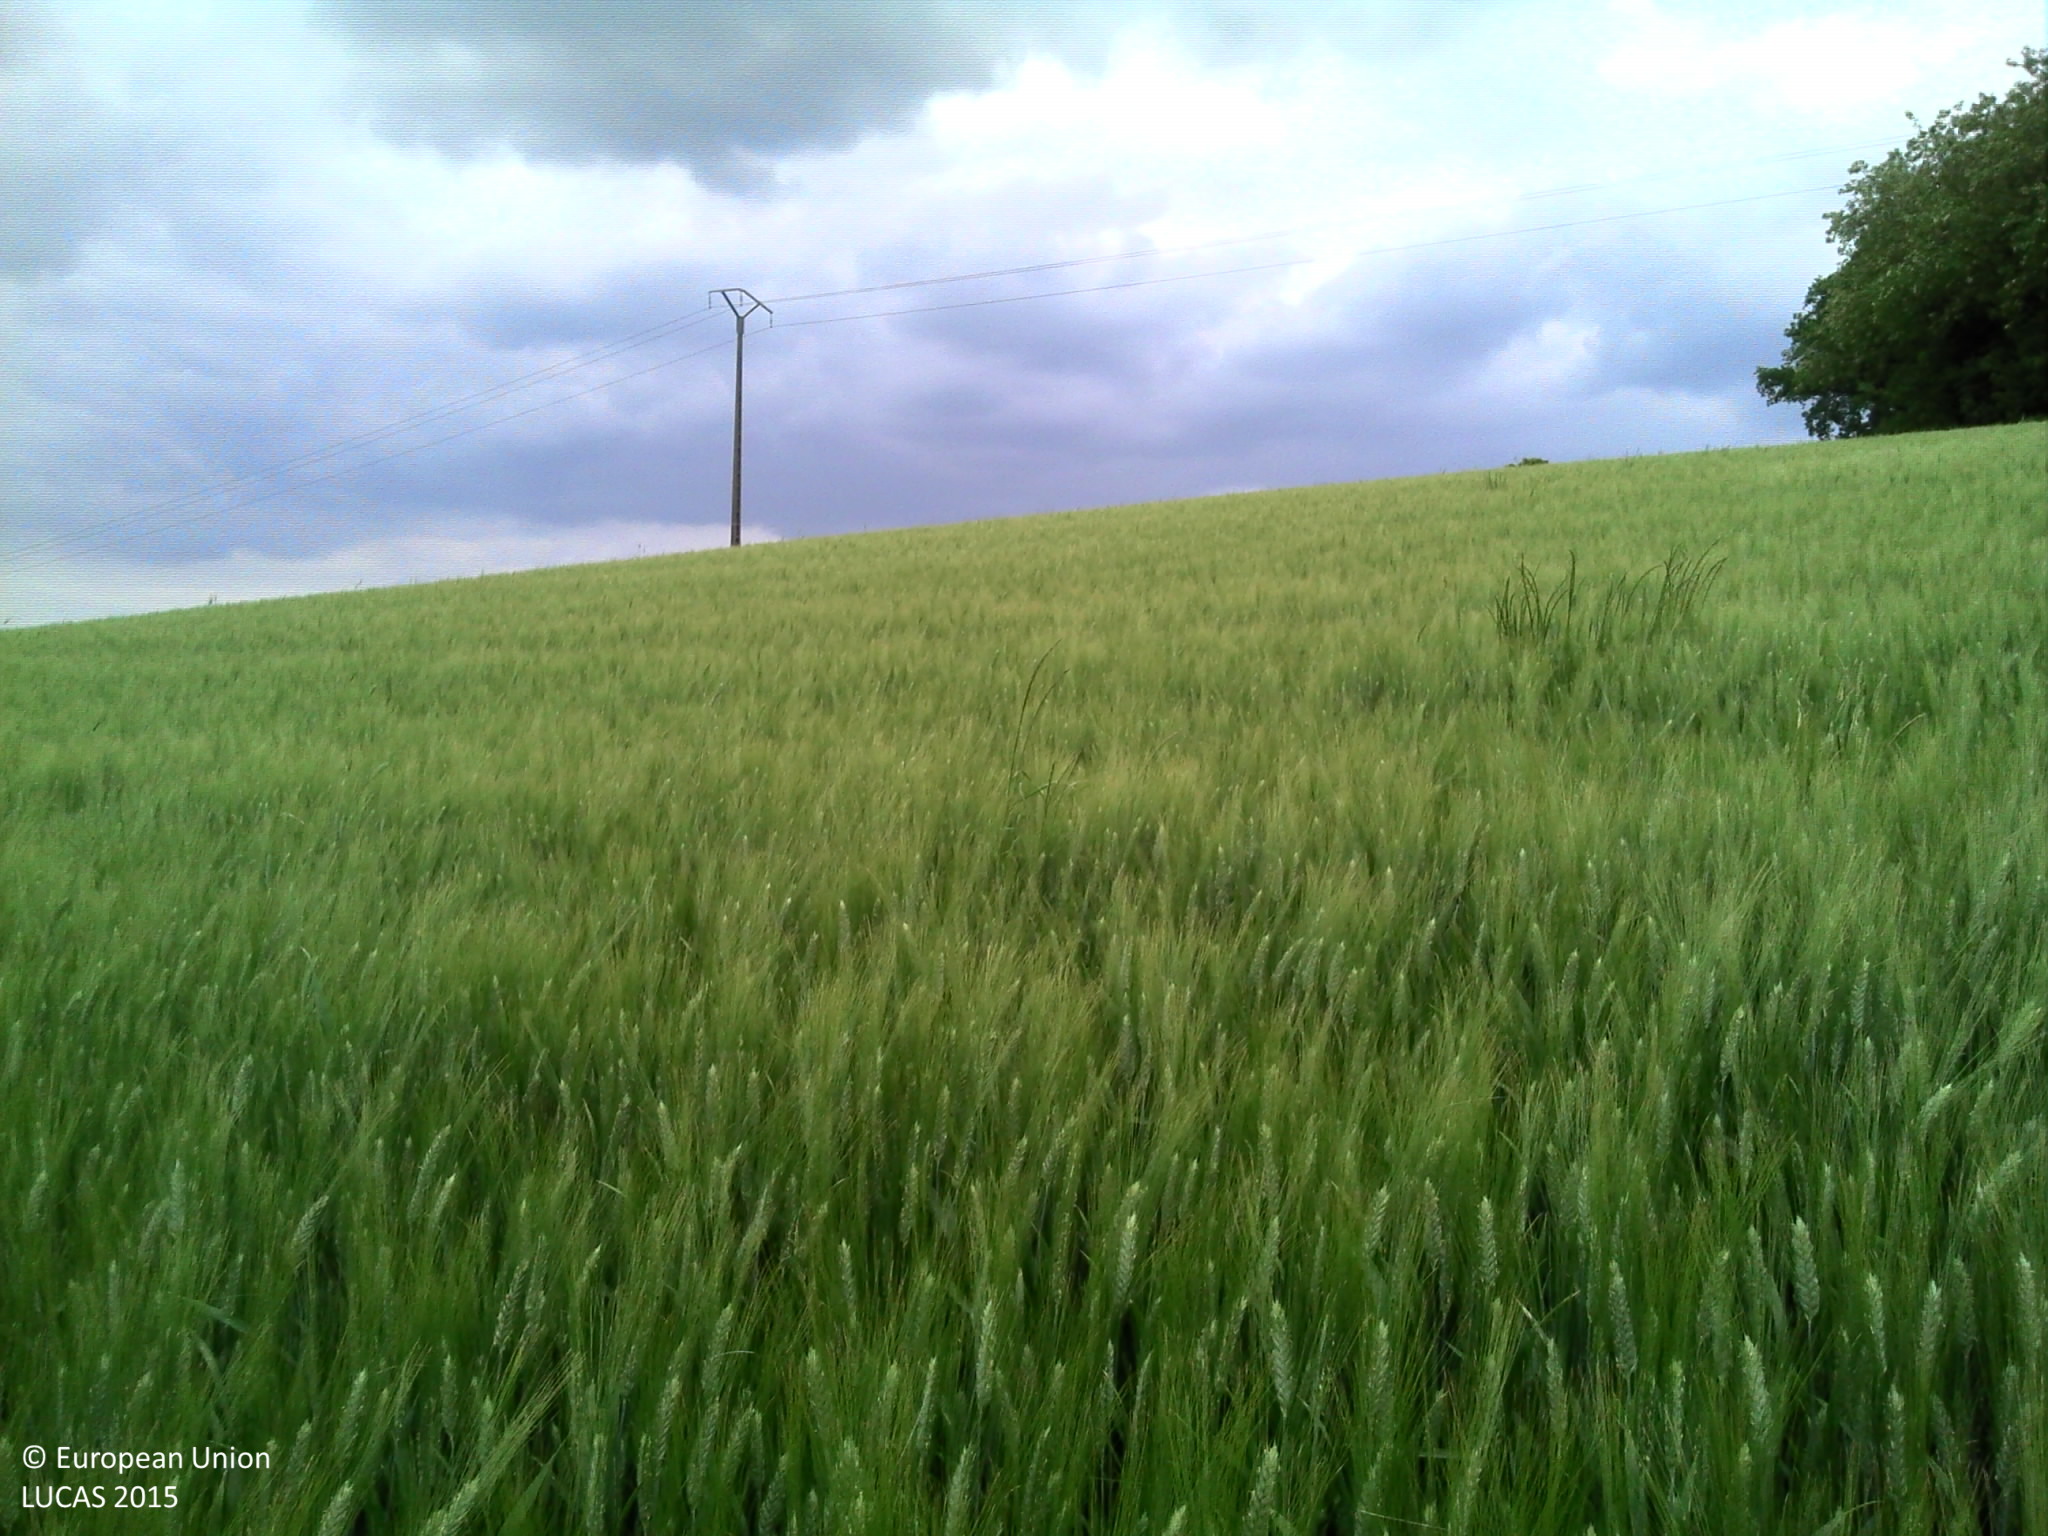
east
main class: Cropland
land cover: Durum wheat
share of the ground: > 75 %
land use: Agriculture (excluding fallow land and kitchen gardens)
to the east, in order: Durum wheat; Electric lines; Durum wheat
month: May
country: FR
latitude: 46.8084
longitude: 0.2161
